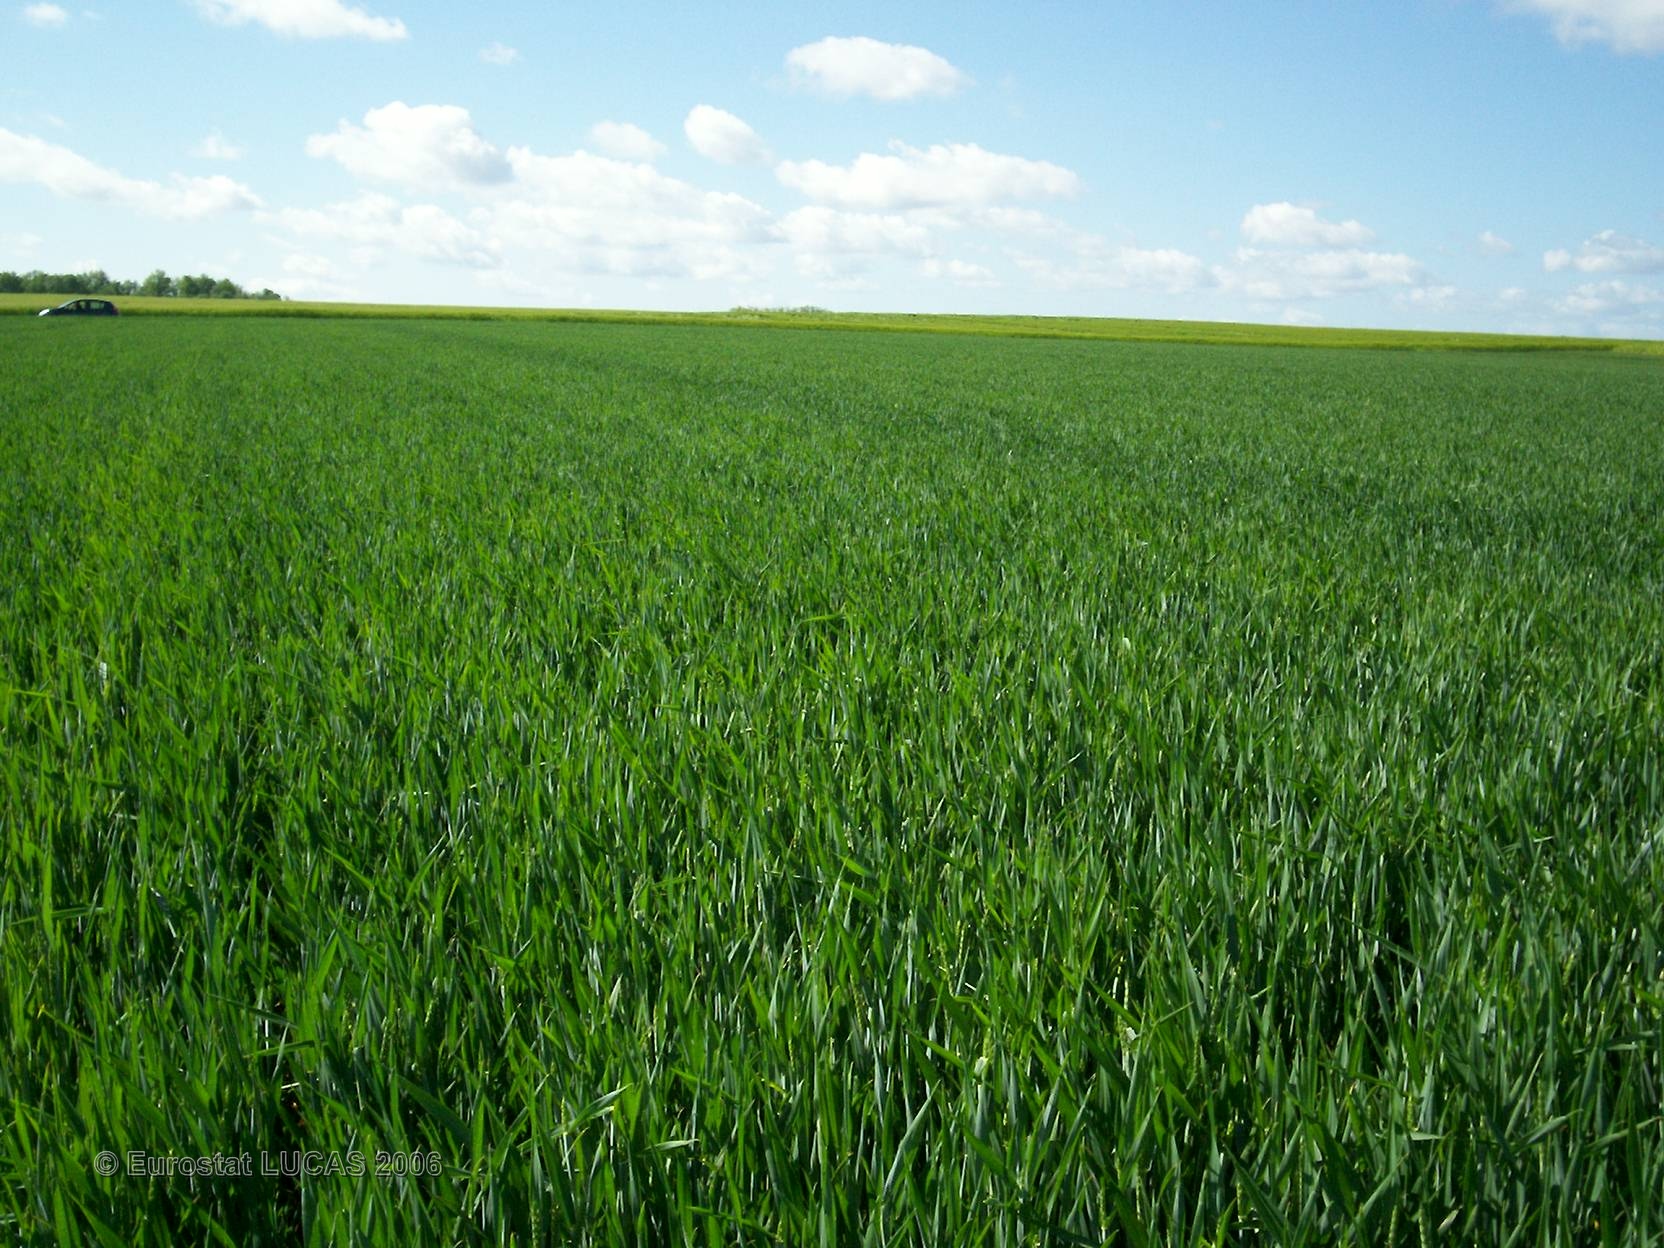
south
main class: Cropland
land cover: Common wheat
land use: Agriculture (excluding fallow land and kitchen gardens)
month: May
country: FR
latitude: 48.1584
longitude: 4.4993
